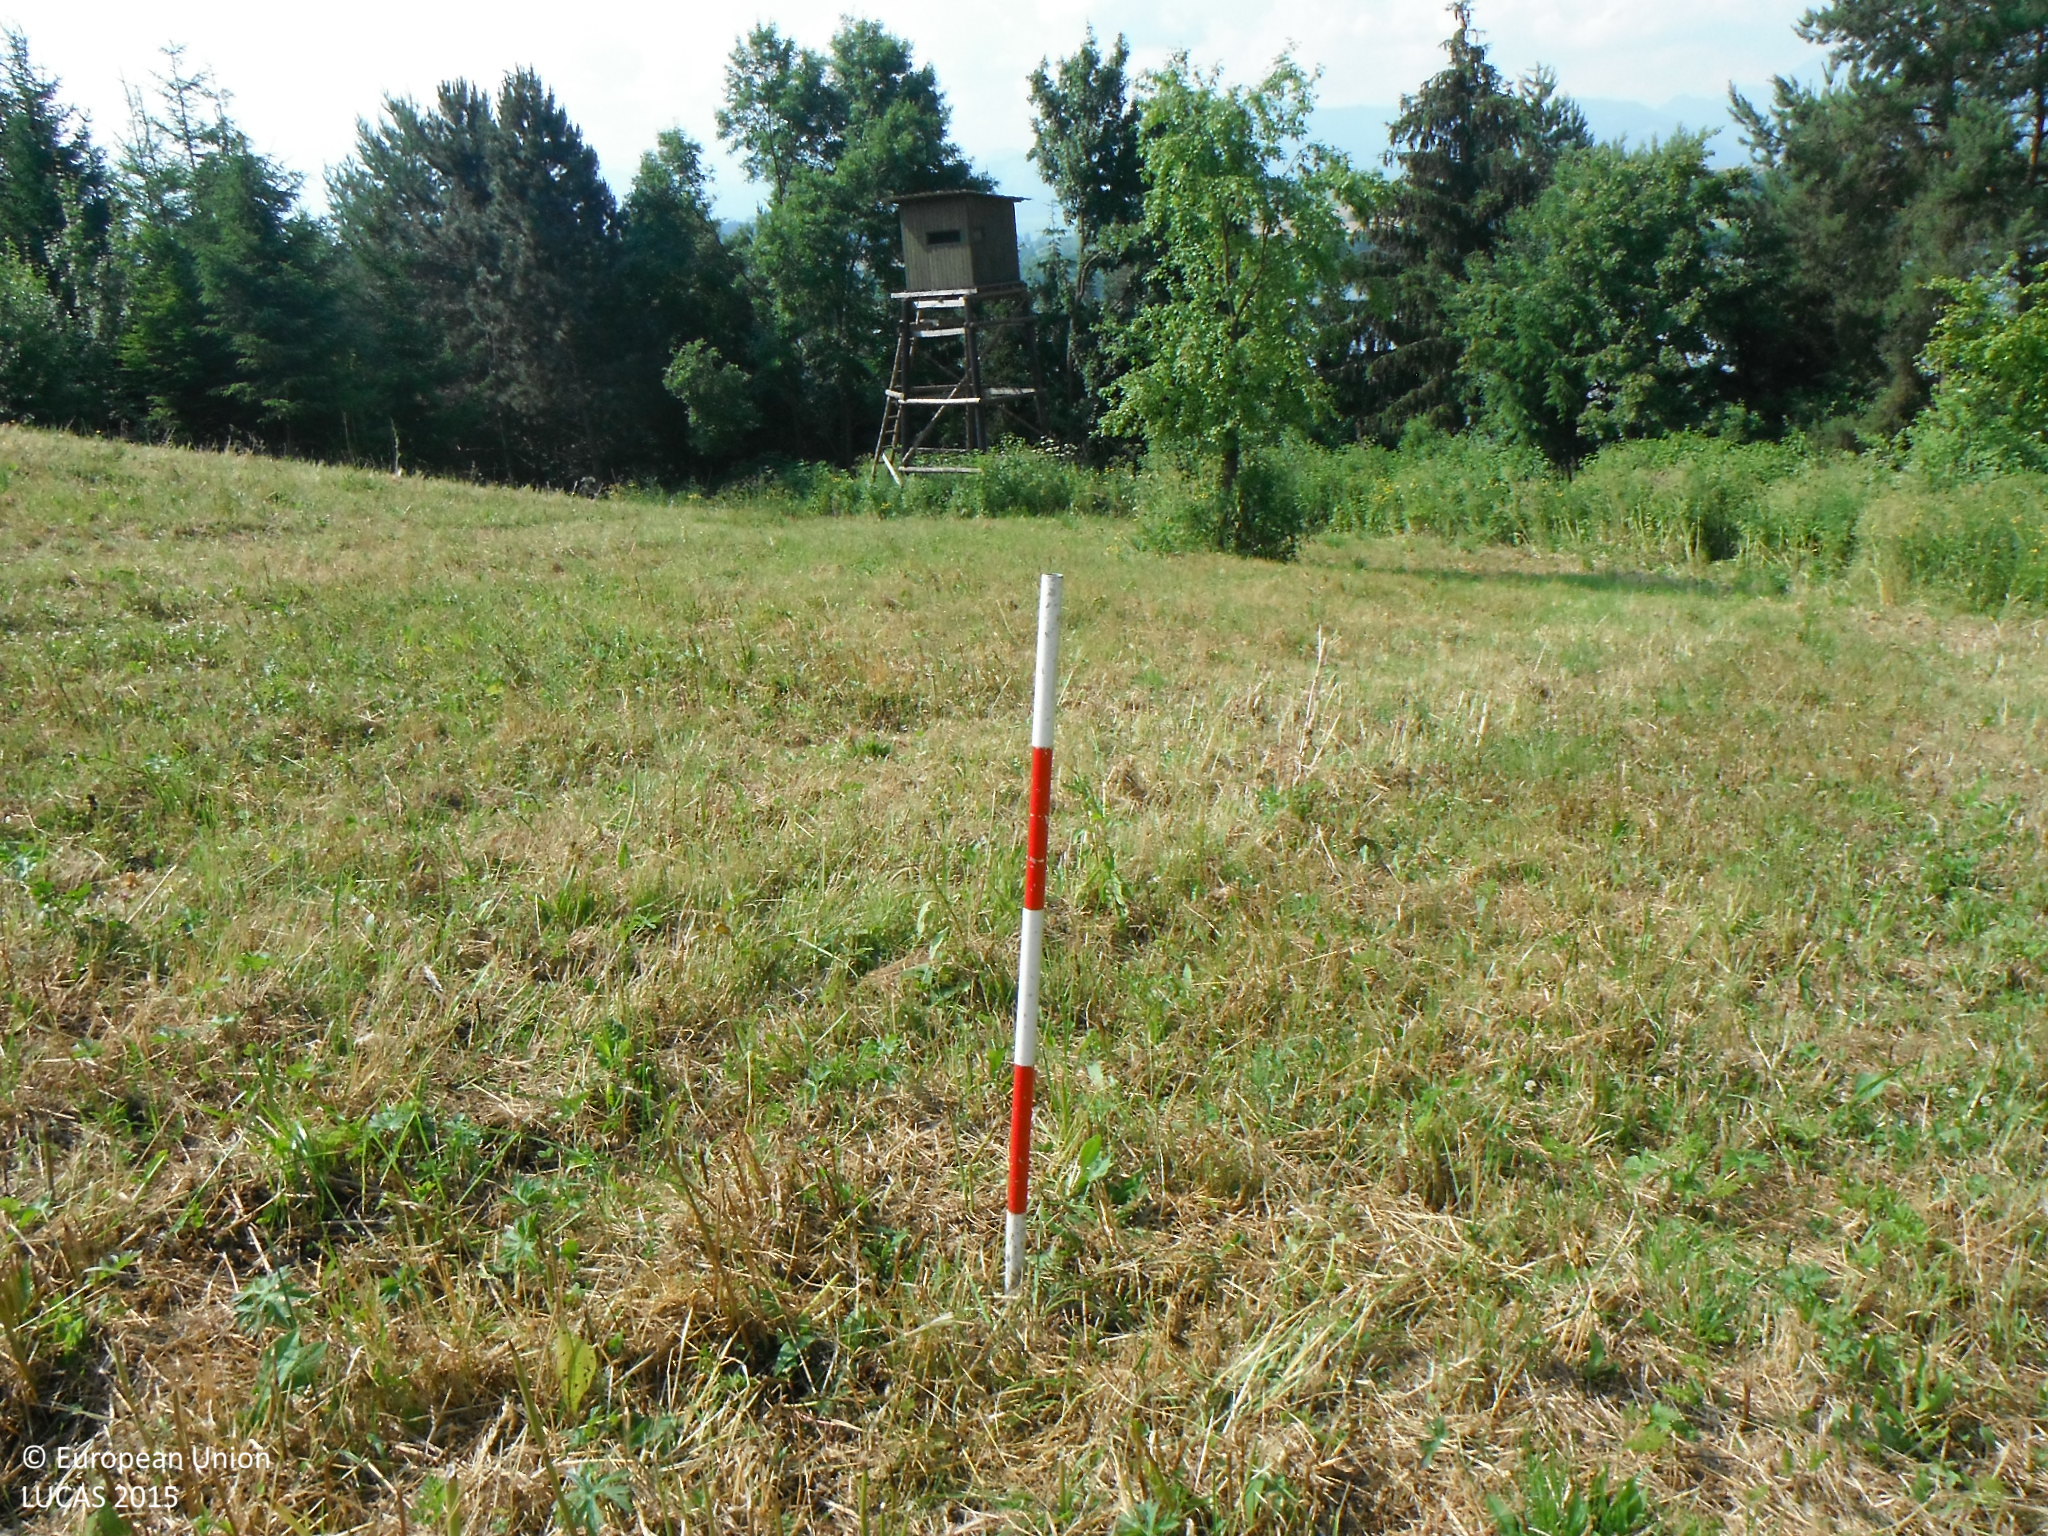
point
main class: Grassland
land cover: Grassland without tree/shrub cover
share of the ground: > 75 %
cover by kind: herbaceous plants 100 %
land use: Agriculture (excluding fallow land and kitchen gardens)
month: July
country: SK
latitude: 49.1017
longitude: 19.4629
